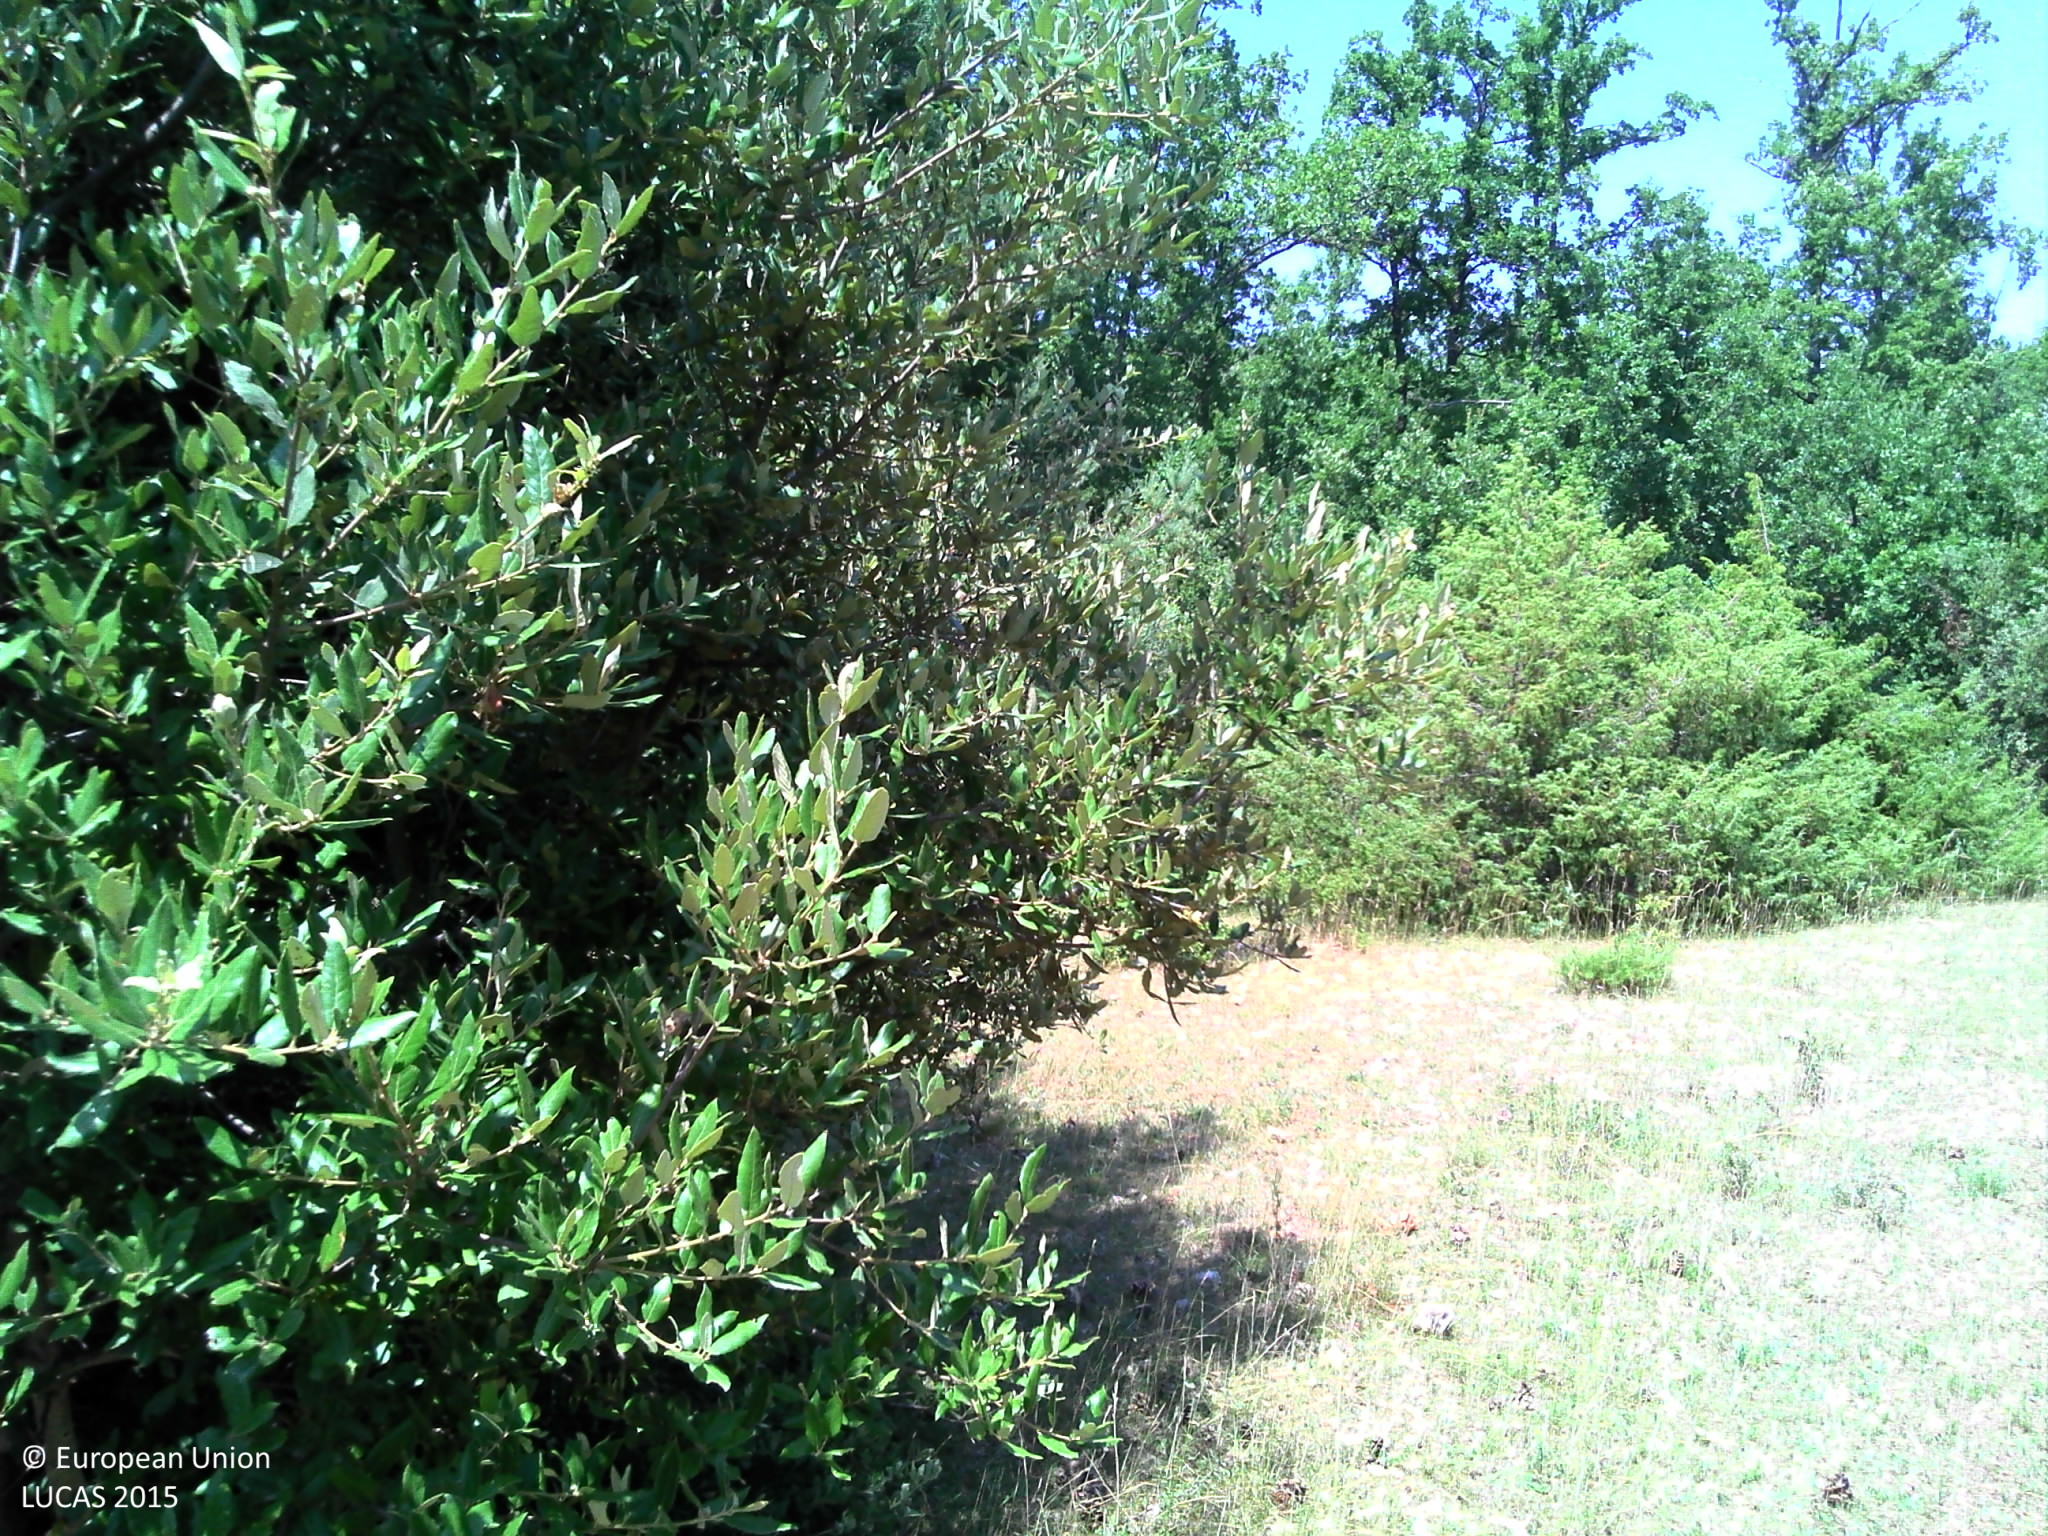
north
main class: Woodland
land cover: Broadleaved woodland
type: broadleaved evergreen forest
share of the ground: 50 - 75 %
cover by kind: herbaceous plants 45 %, broadleaved forest trees 40 %, shrubs 10 %, coniferous forest trees 5 %
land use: Agriculture (excluding fallow land and kitchen gardens)
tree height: > 5 m
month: July
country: FR
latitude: 44.0095
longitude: 5.3061
